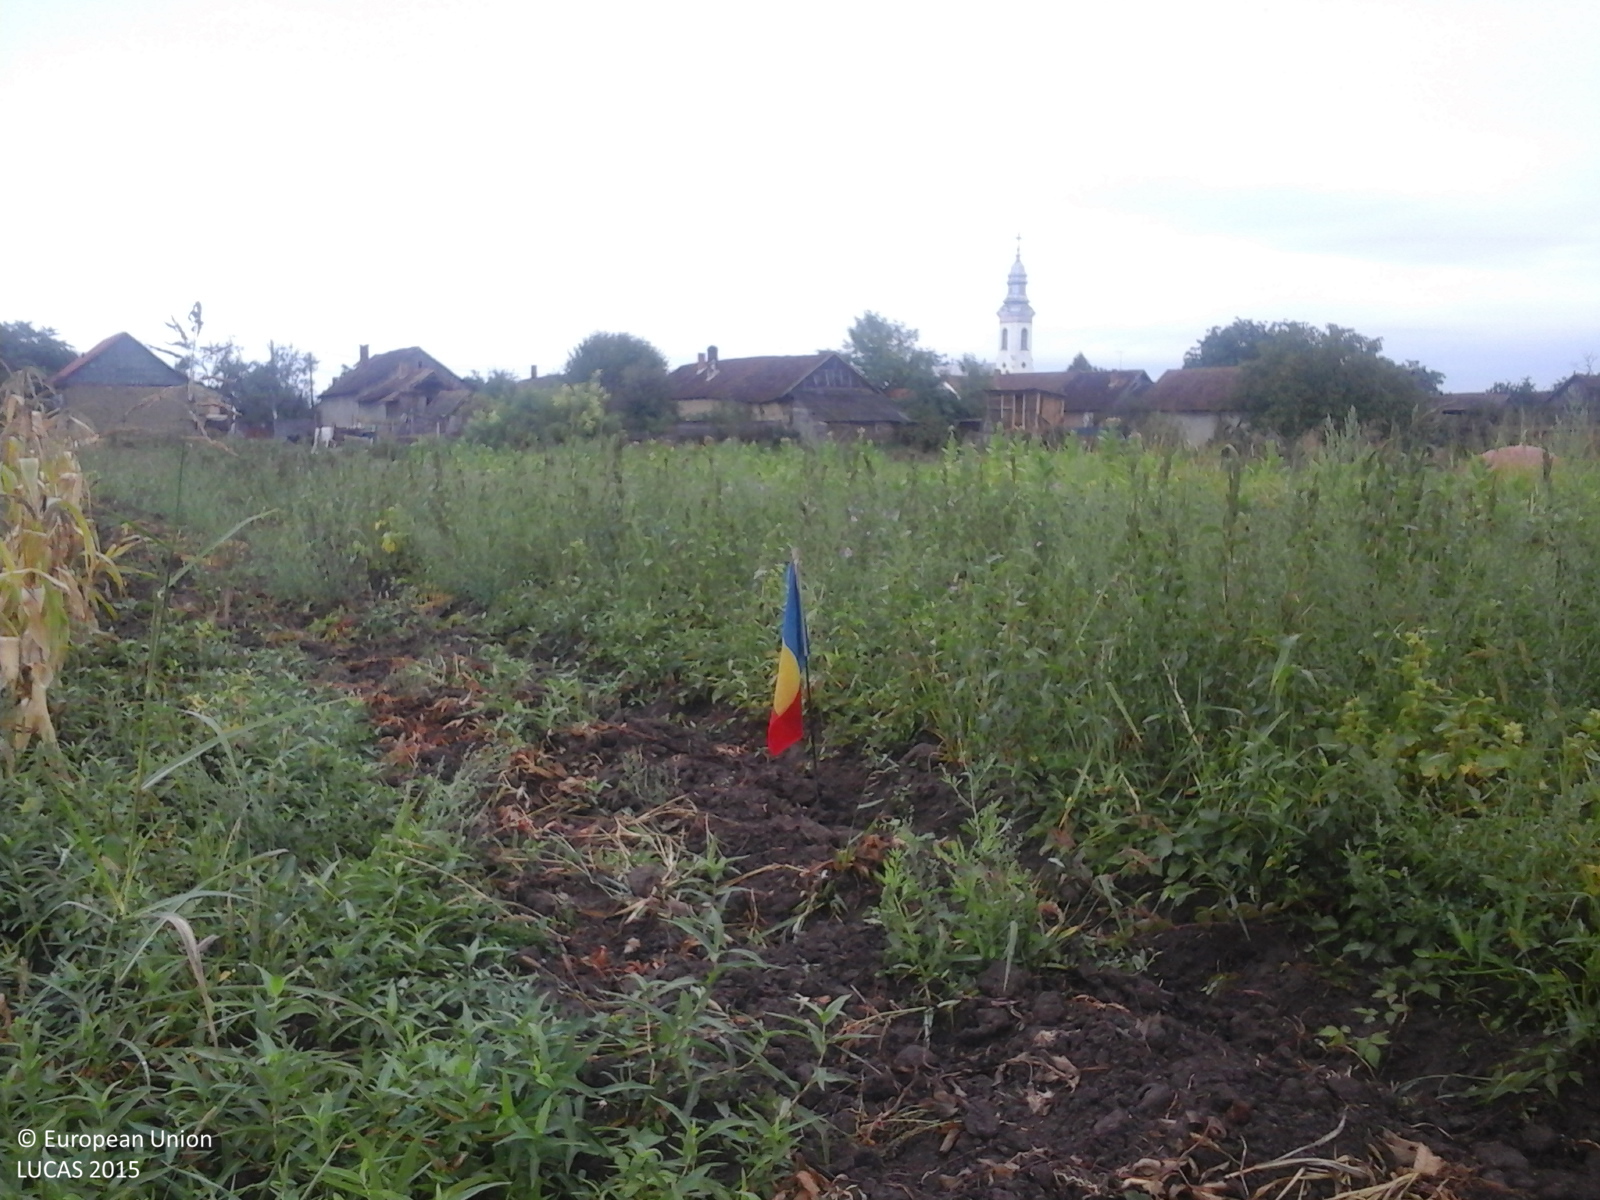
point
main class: Grassland
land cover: Spontaneously vegetated surfaces
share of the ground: > 75 %
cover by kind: herbaceous plants 100 %
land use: Agriculture (excluding fallow land and kitchen gardens)
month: September
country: RO
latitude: 47.2343
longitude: 21.8683
